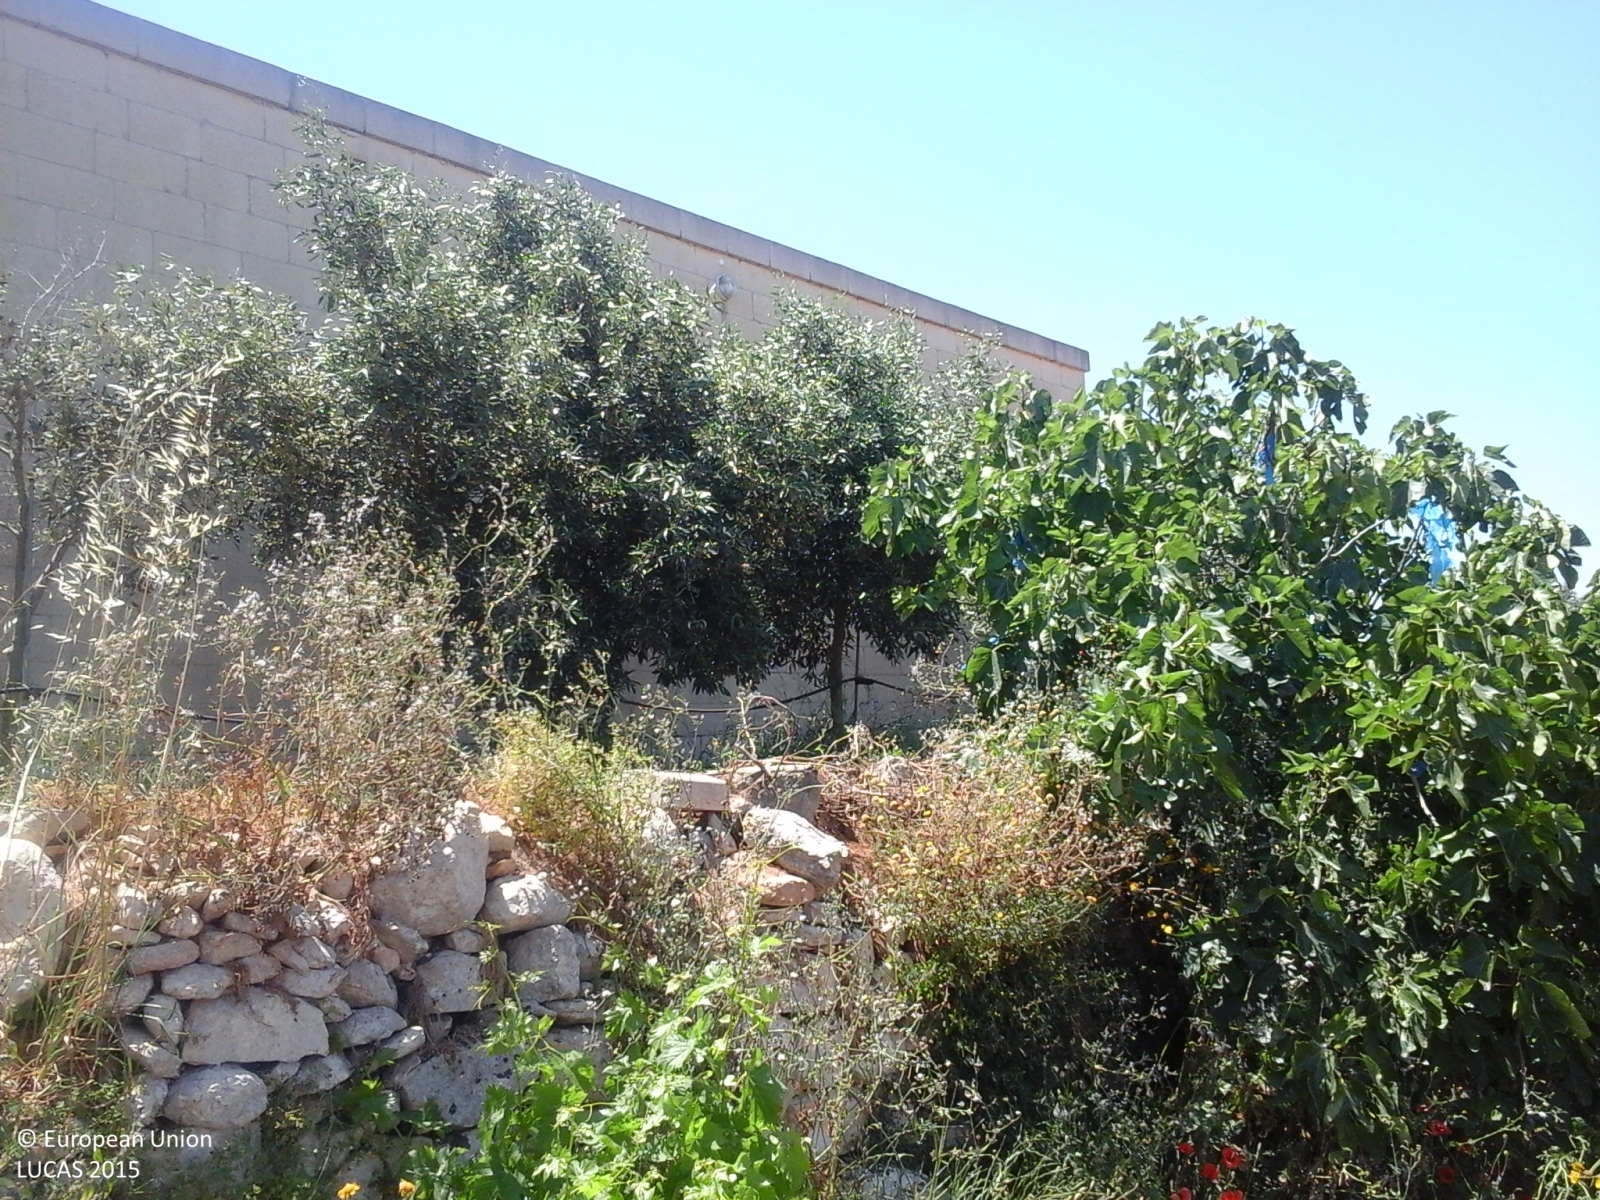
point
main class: Cropland
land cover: Olive groves
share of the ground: 10 - 25 %
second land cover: Spontaneously vegetated surfaces
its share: 10 - 25 %
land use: Agriculture (excluding fallow land and kitchen gardens)
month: May
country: MT
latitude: 35.8218
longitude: 14.4852
